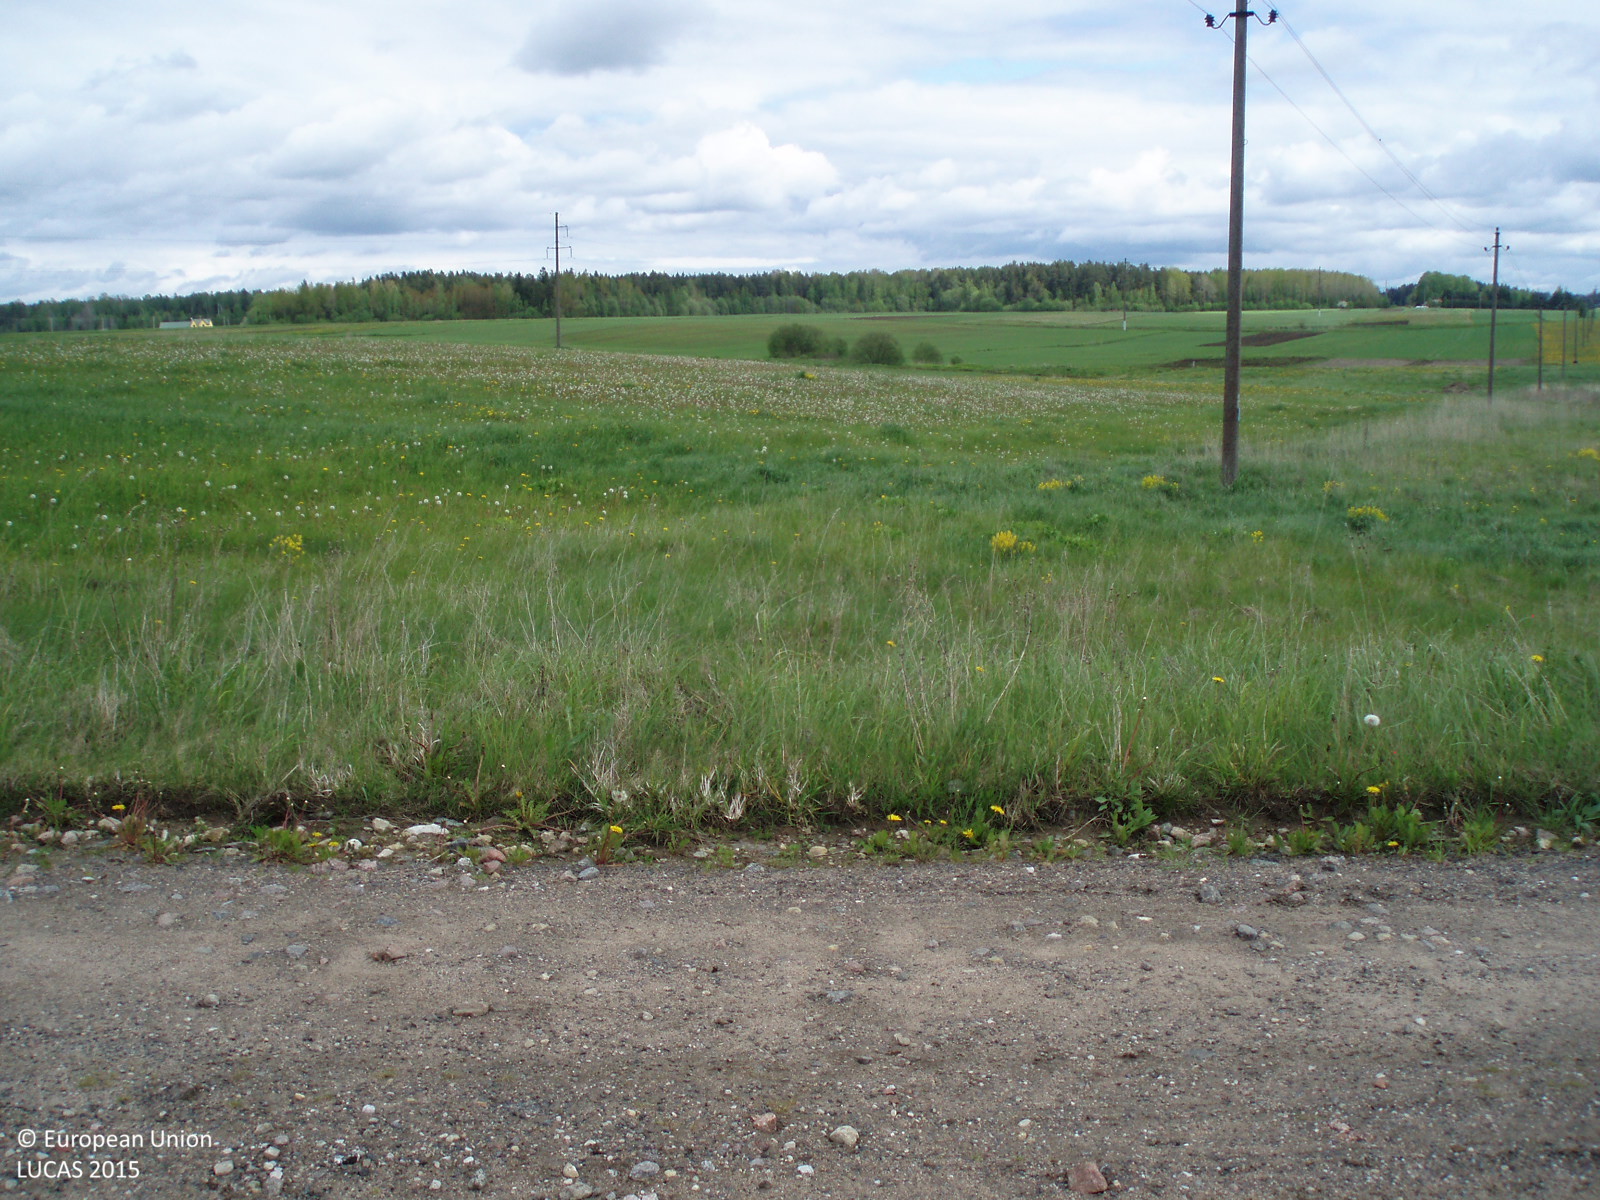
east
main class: Grassland
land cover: Grassland without tree/shrub cover
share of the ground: > 75 %
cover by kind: herbaceous plants 100 %
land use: Agriculture (excluding fallow land and kitchen gardens)
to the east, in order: Paved roads, cycling and walking lanes; Grassland without tree/shrub cover; Electric lines; Grassland without tree/shrub cover; Common wheat; Rye; Grassland without tree/shrub cover; Electric lines; Common wheat
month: May
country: LT
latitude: 56.2746
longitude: 22.4111
